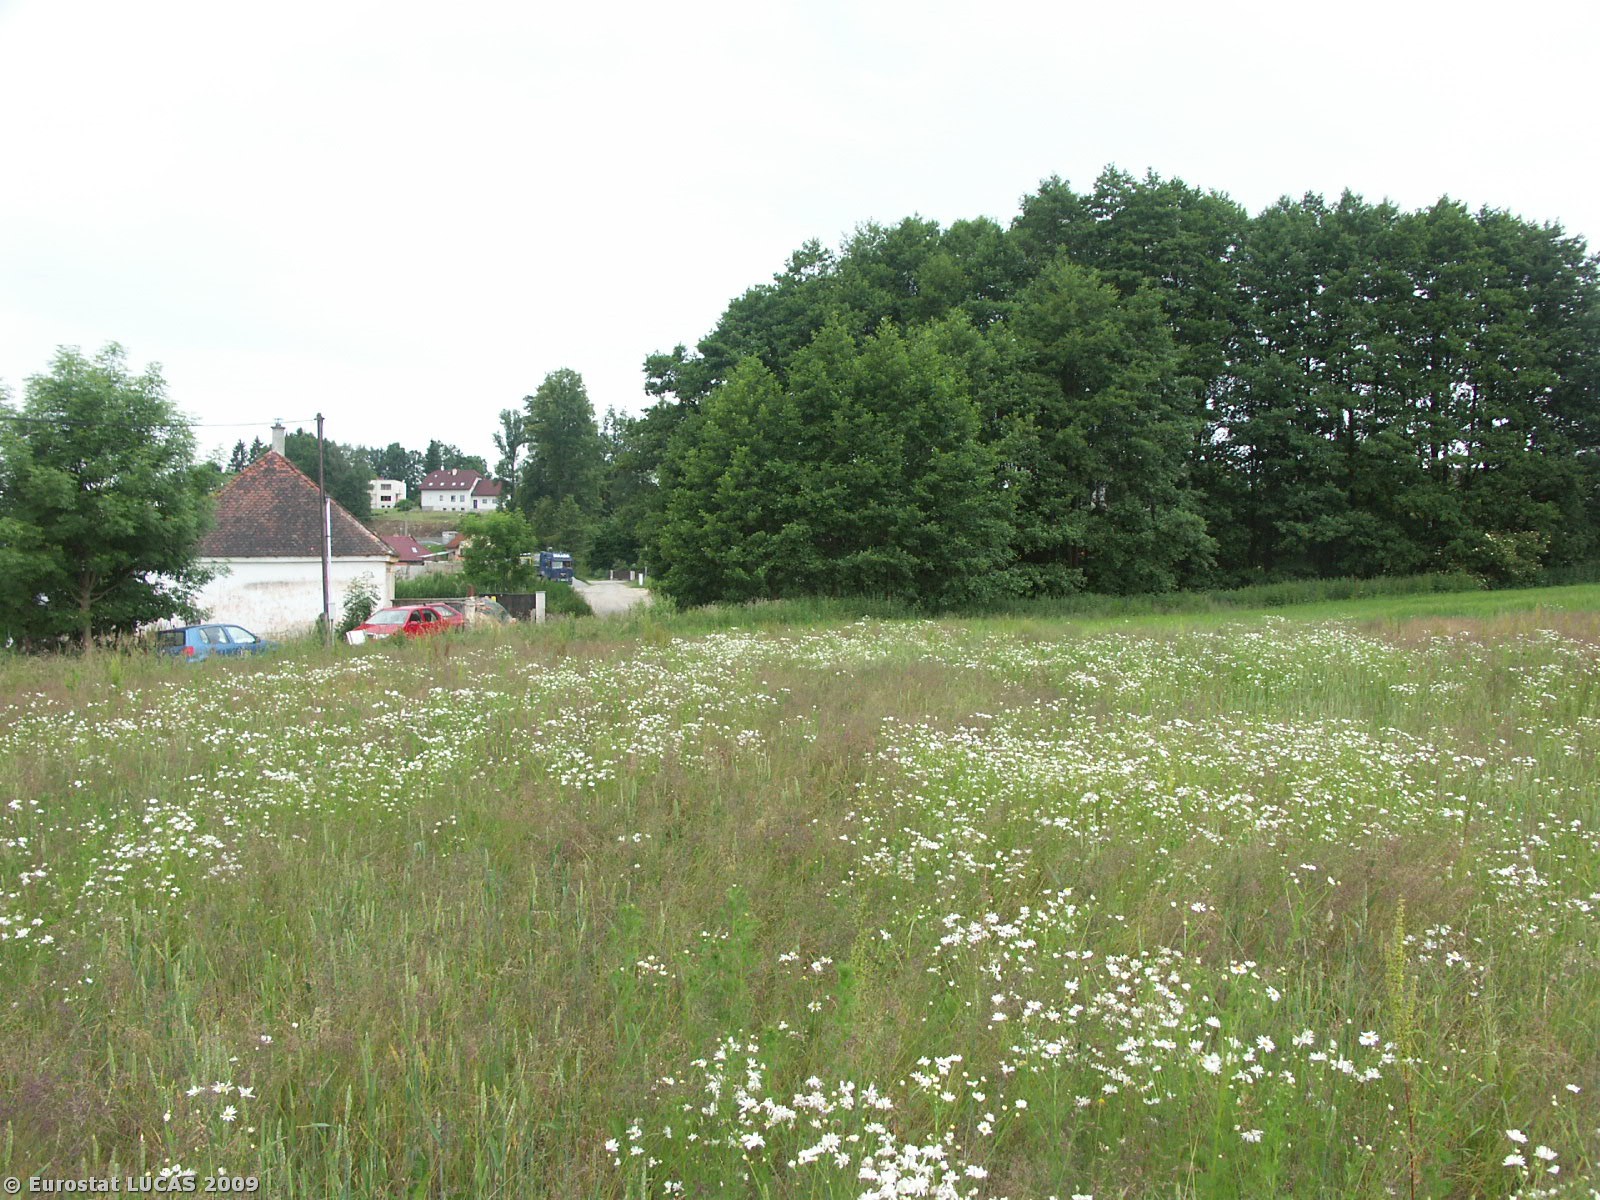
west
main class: Grassland
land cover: Spontaneously vegetated surfaces
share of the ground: > 75 %
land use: Fallow land
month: June
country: CZ
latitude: 48.9373
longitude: 14.6292
